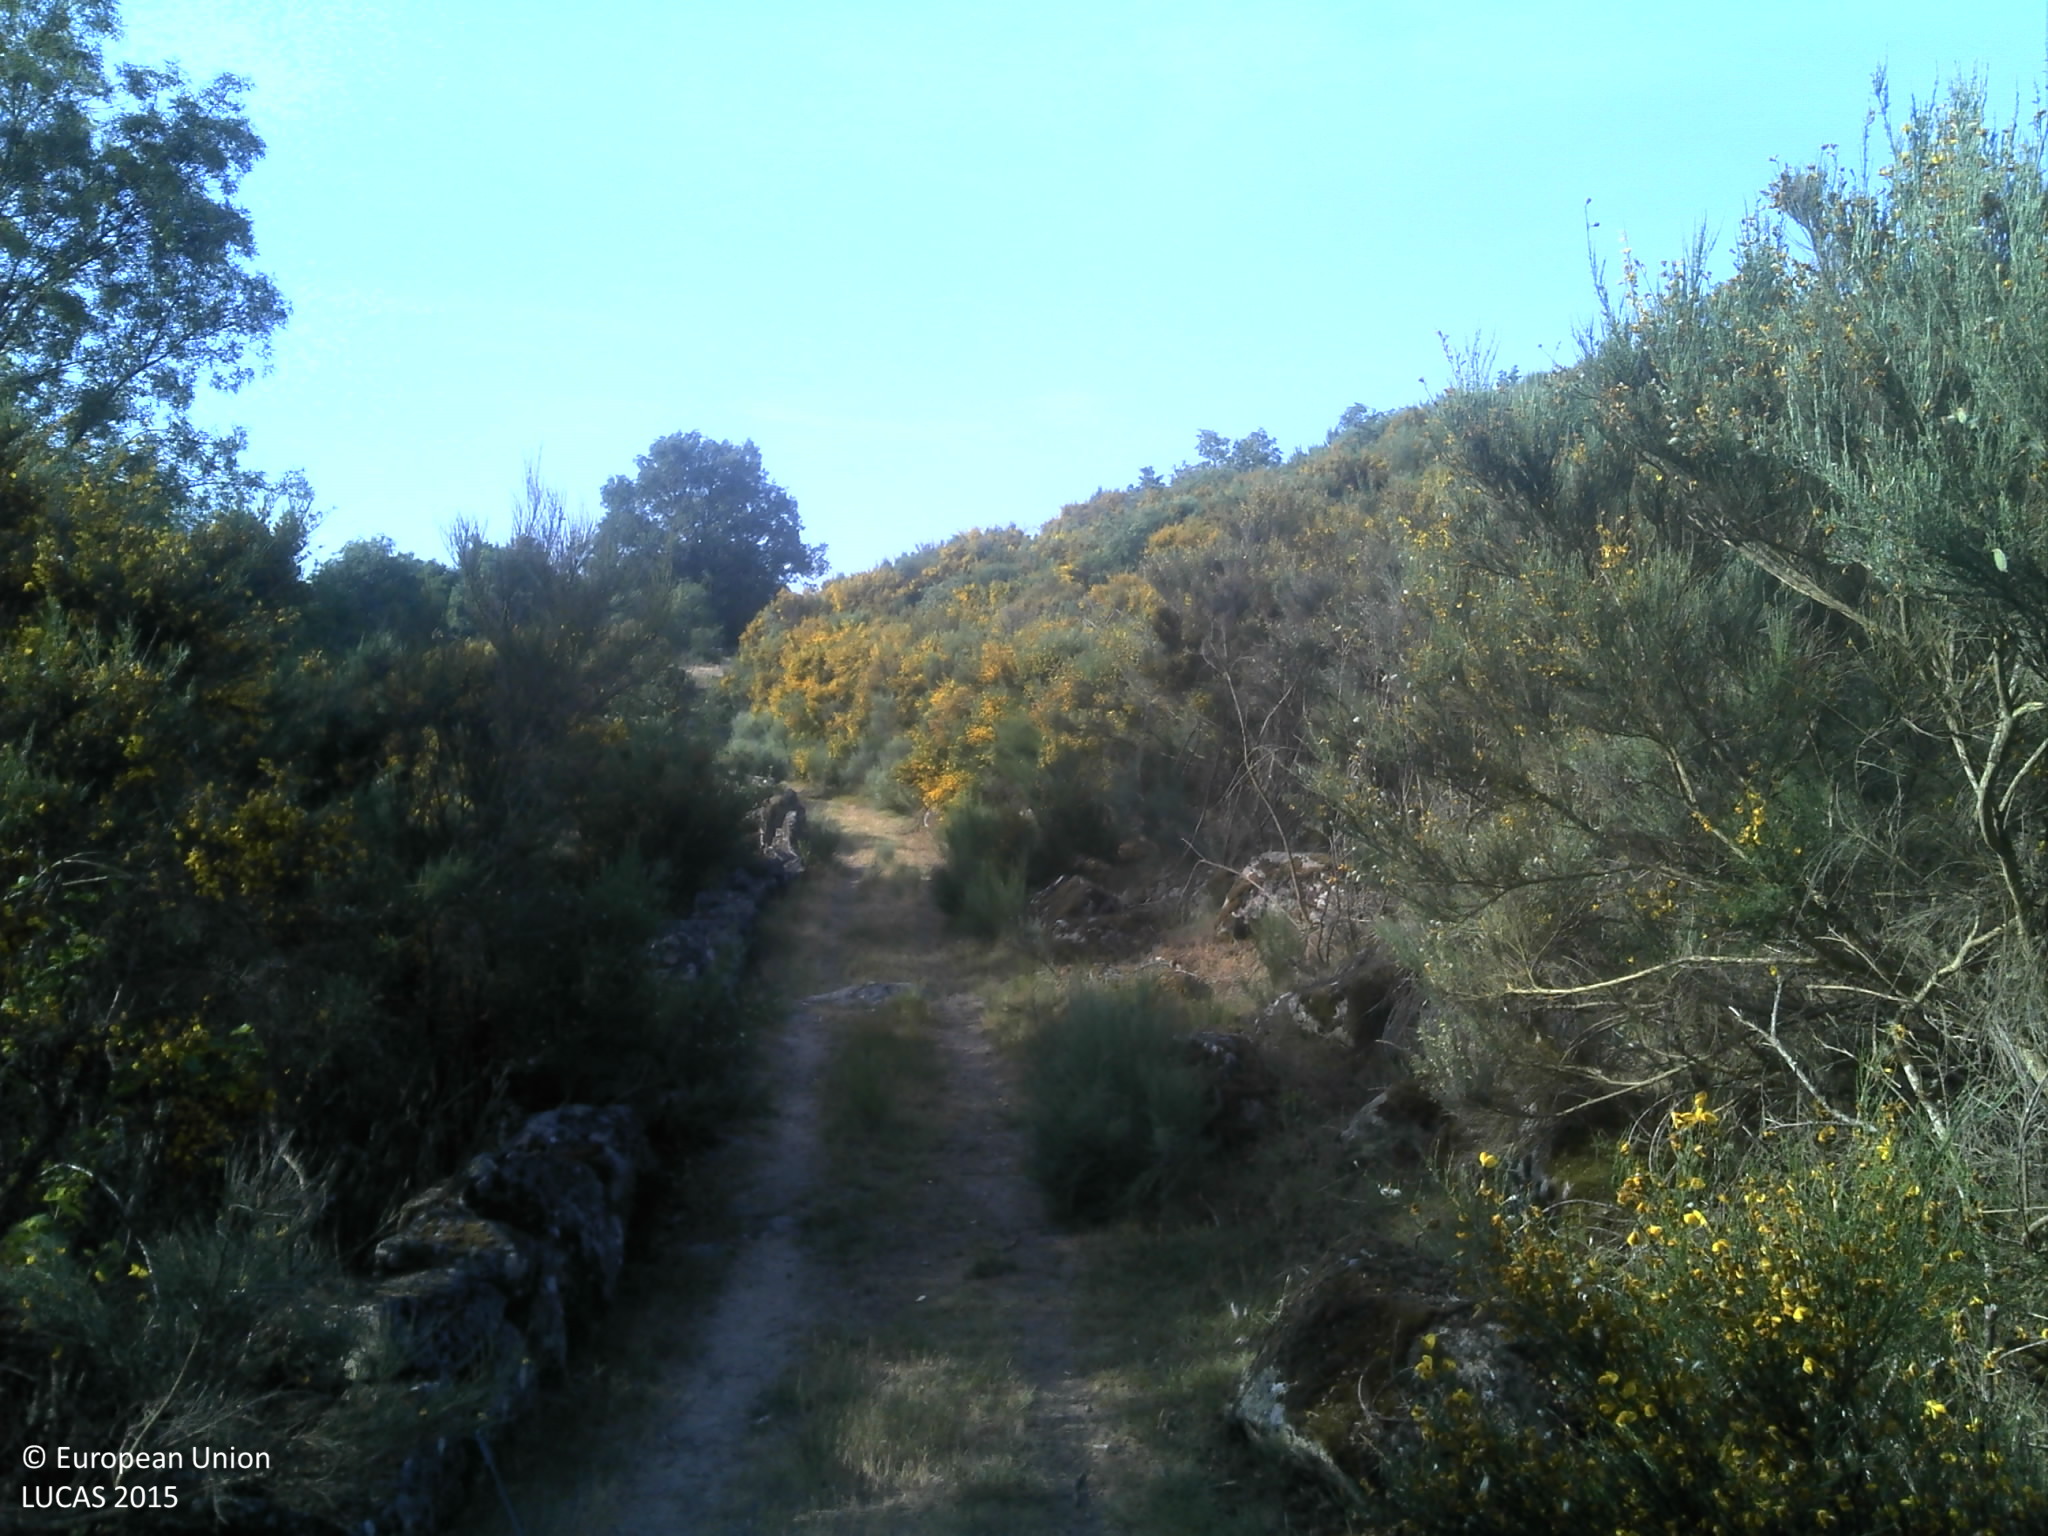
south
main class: Shrubland
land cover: Shrubland without tree cover
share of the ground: 50 - 75 %
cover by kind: shrubs 75 %, unconsolidated bare surface 10 %, herbaceous plants 5 %
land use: Abandoned areas
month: June
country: PT
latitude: 40.3717
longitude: -7.0213
